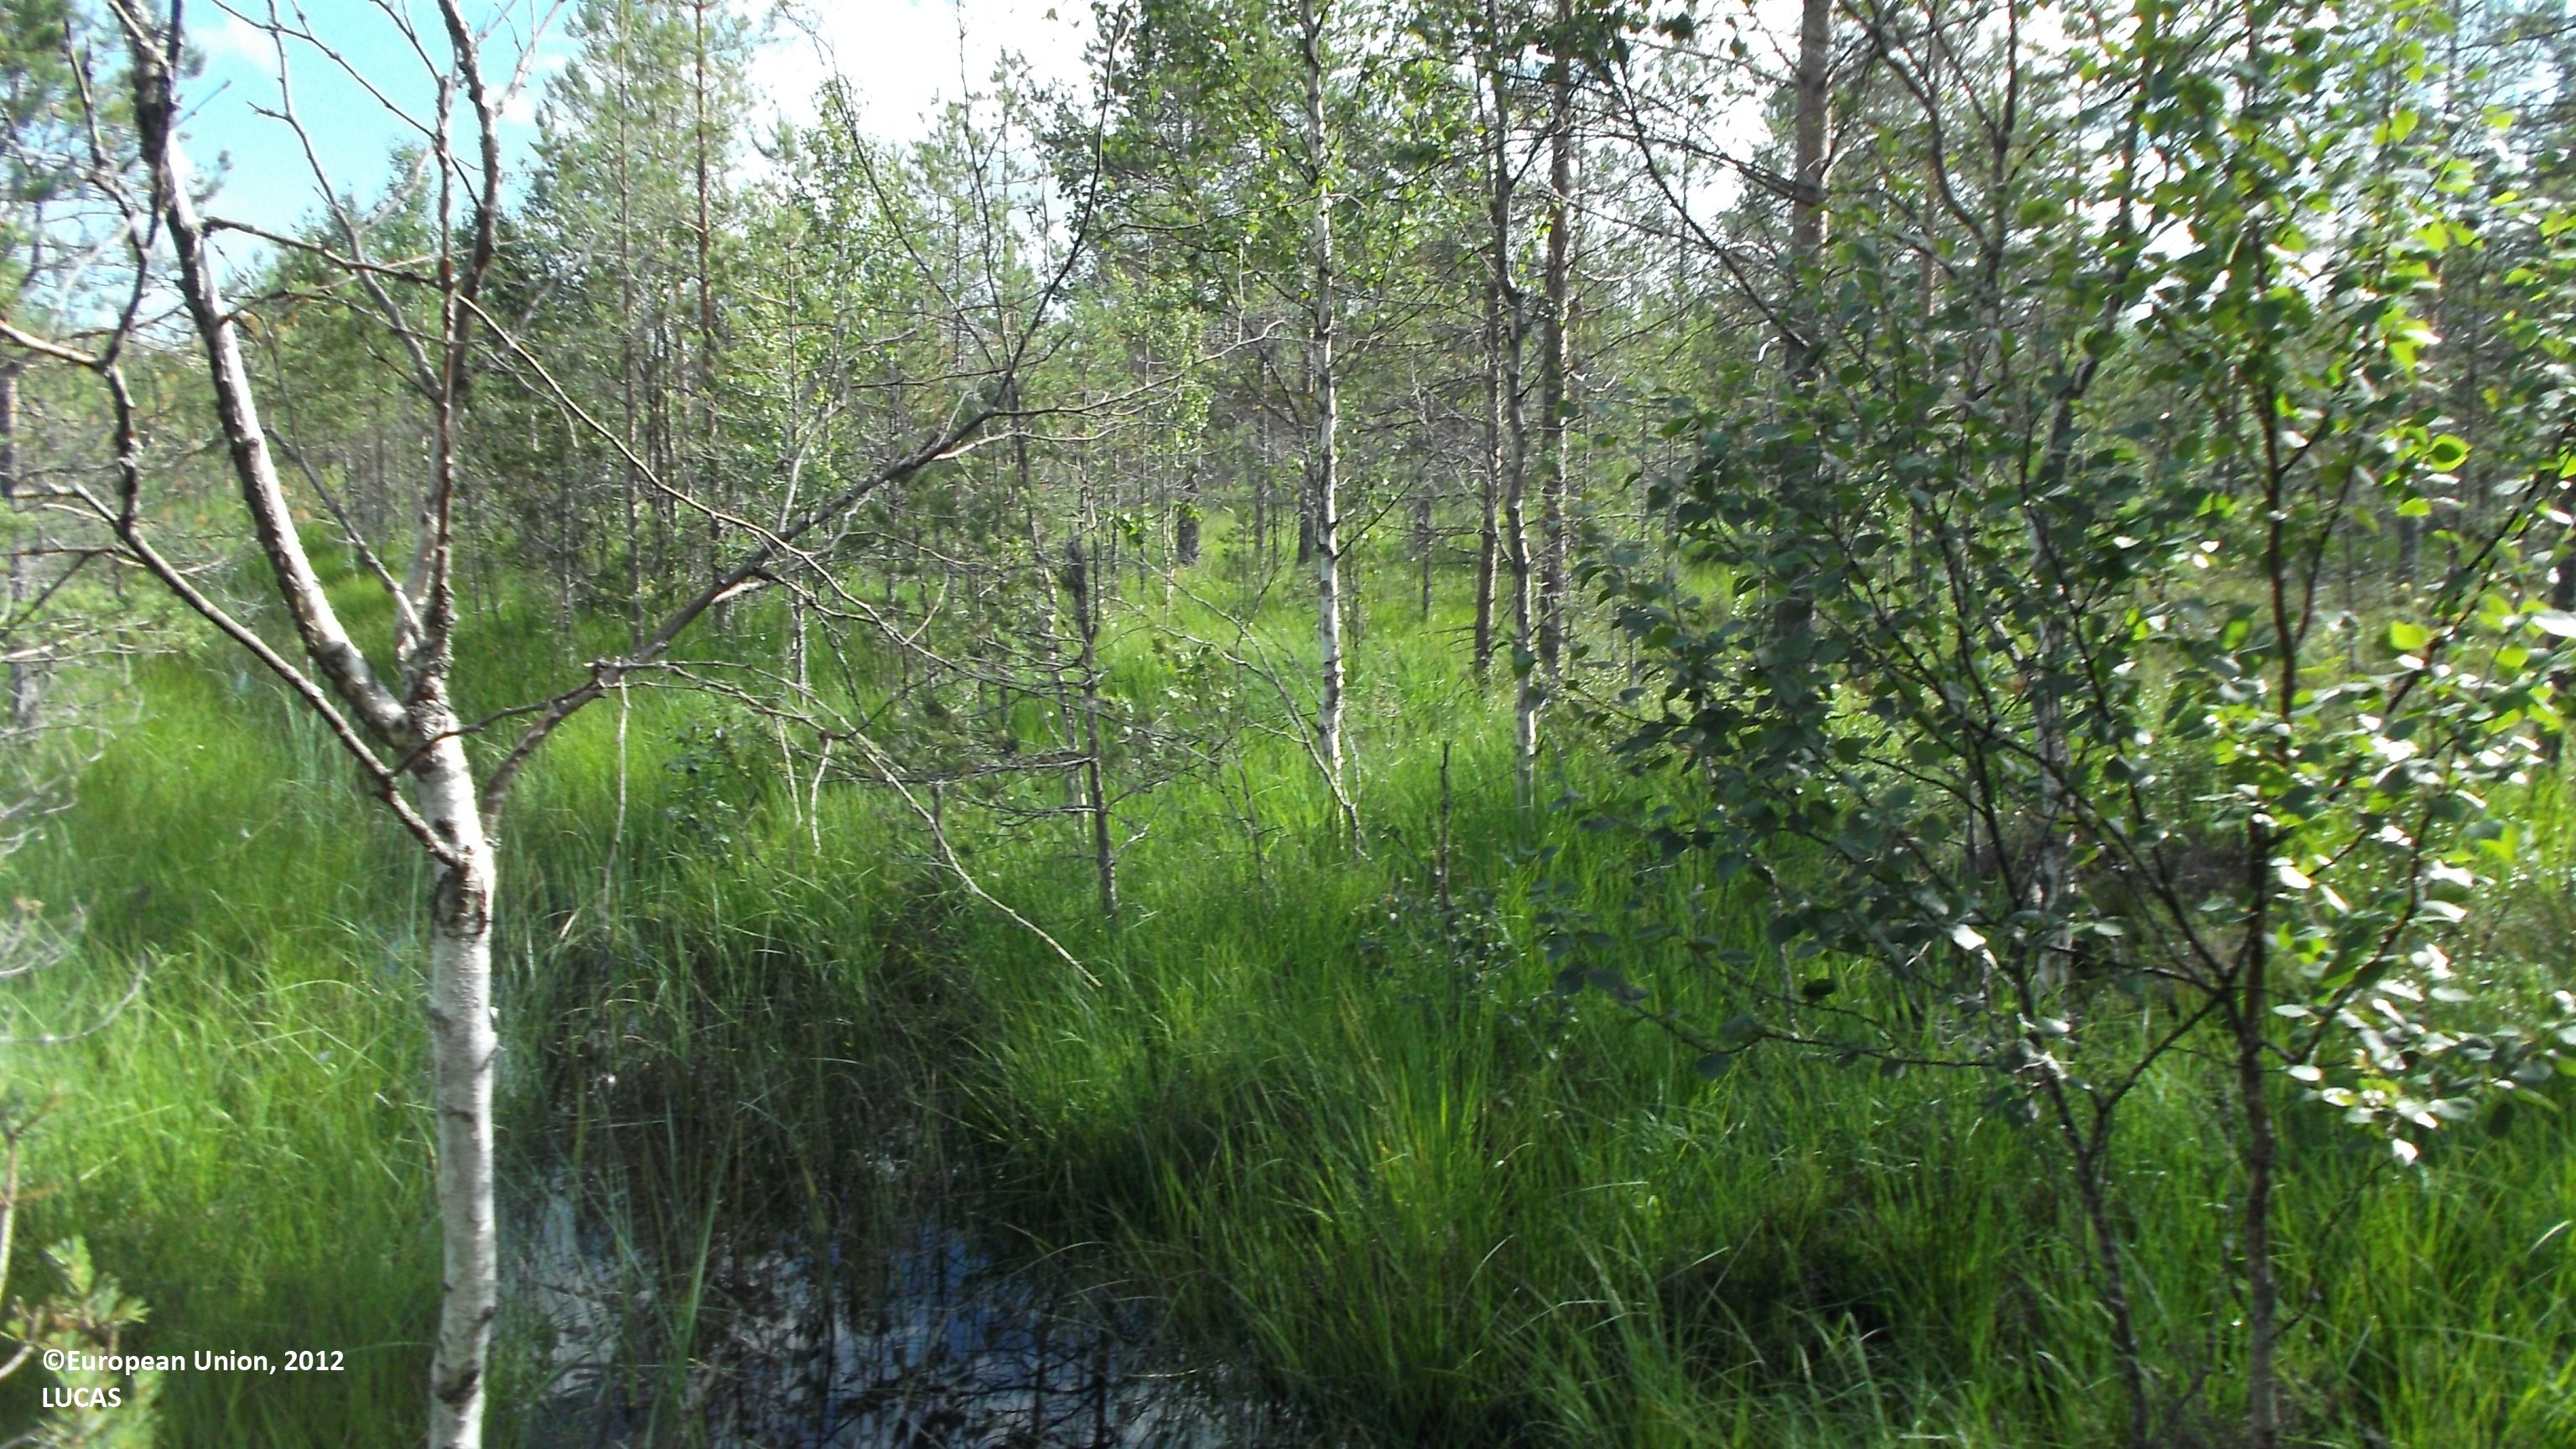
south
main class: Woodland
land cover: Pine dominated mixed woodland
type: mire and swamp forests
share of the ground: 25 - 50 %
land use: Forestry
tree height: > 5 m
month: July
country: FI
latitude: 63.4160
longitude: 24.4813
